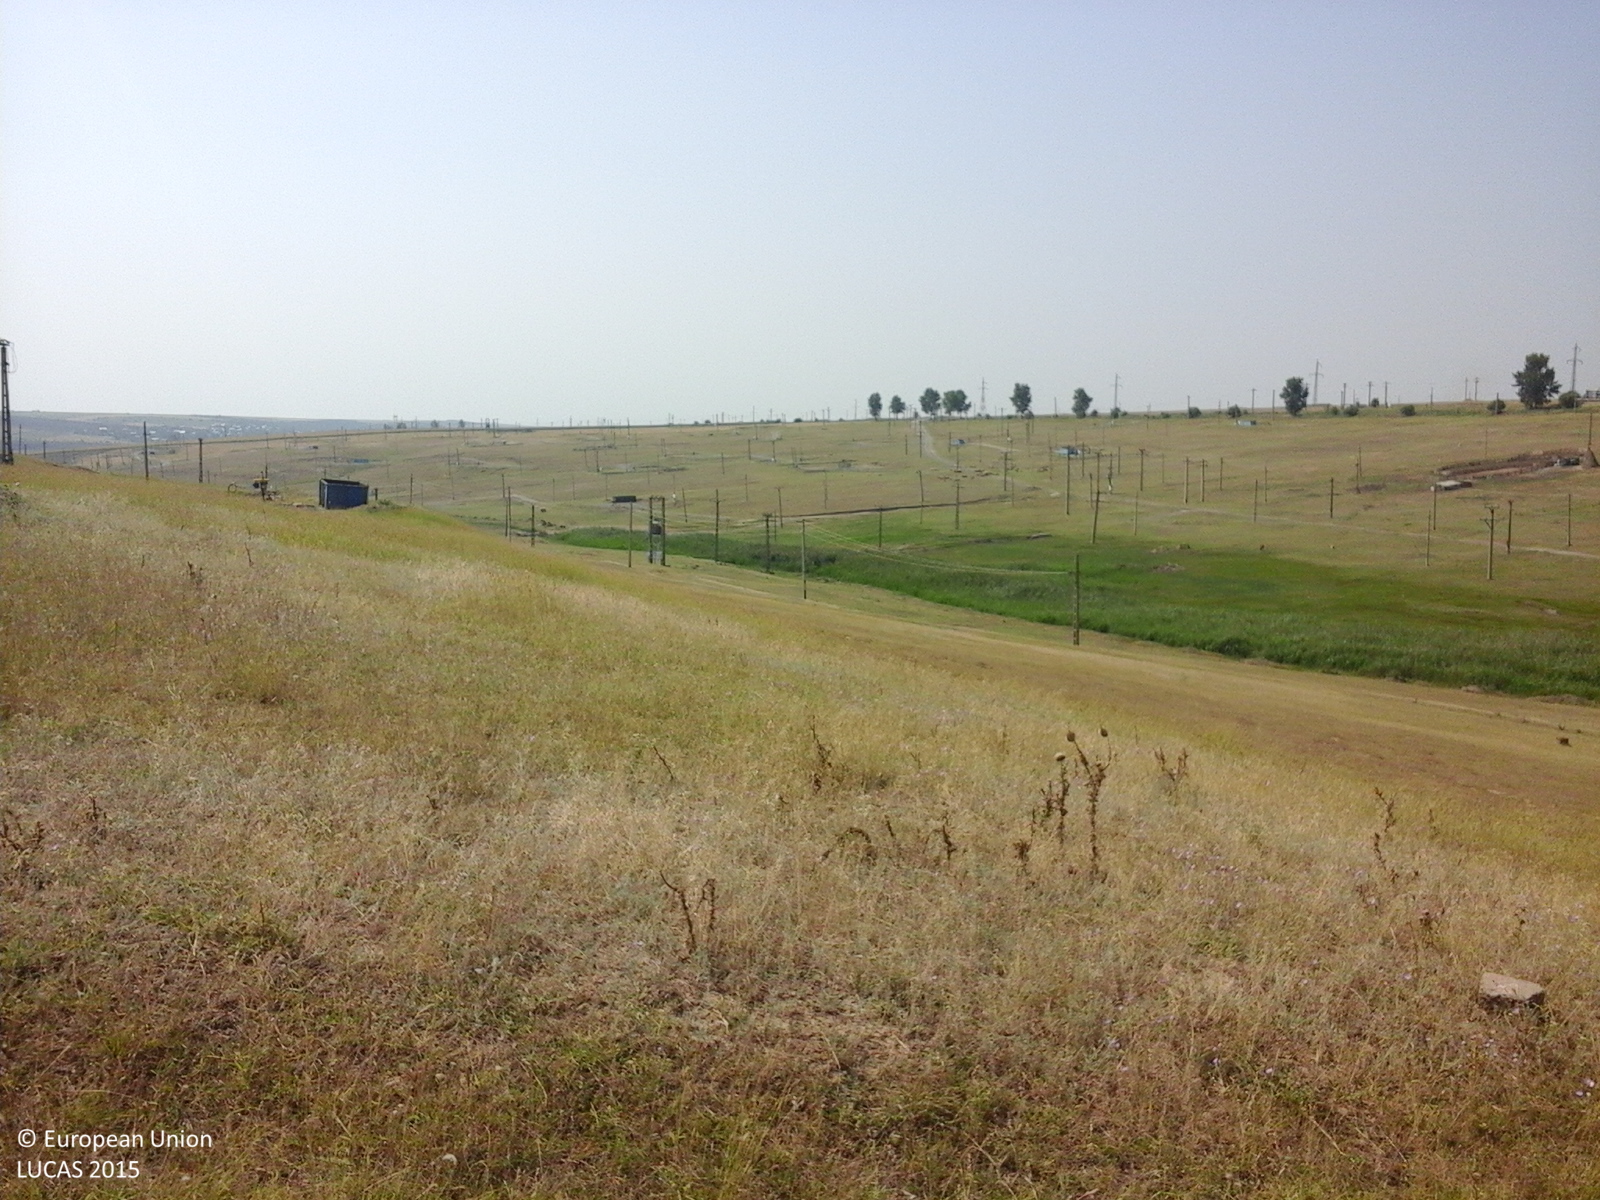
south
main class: Grassland
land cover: Grassland without tree/shrub cover
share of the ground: > 75 %
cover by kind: herbaceous plants 100 %
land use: Agriculture (excluding fallow land and kitchen gardens)
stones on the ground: 10 - 25 %
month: July
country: RO
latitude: 45.5388
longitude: 27.8238
